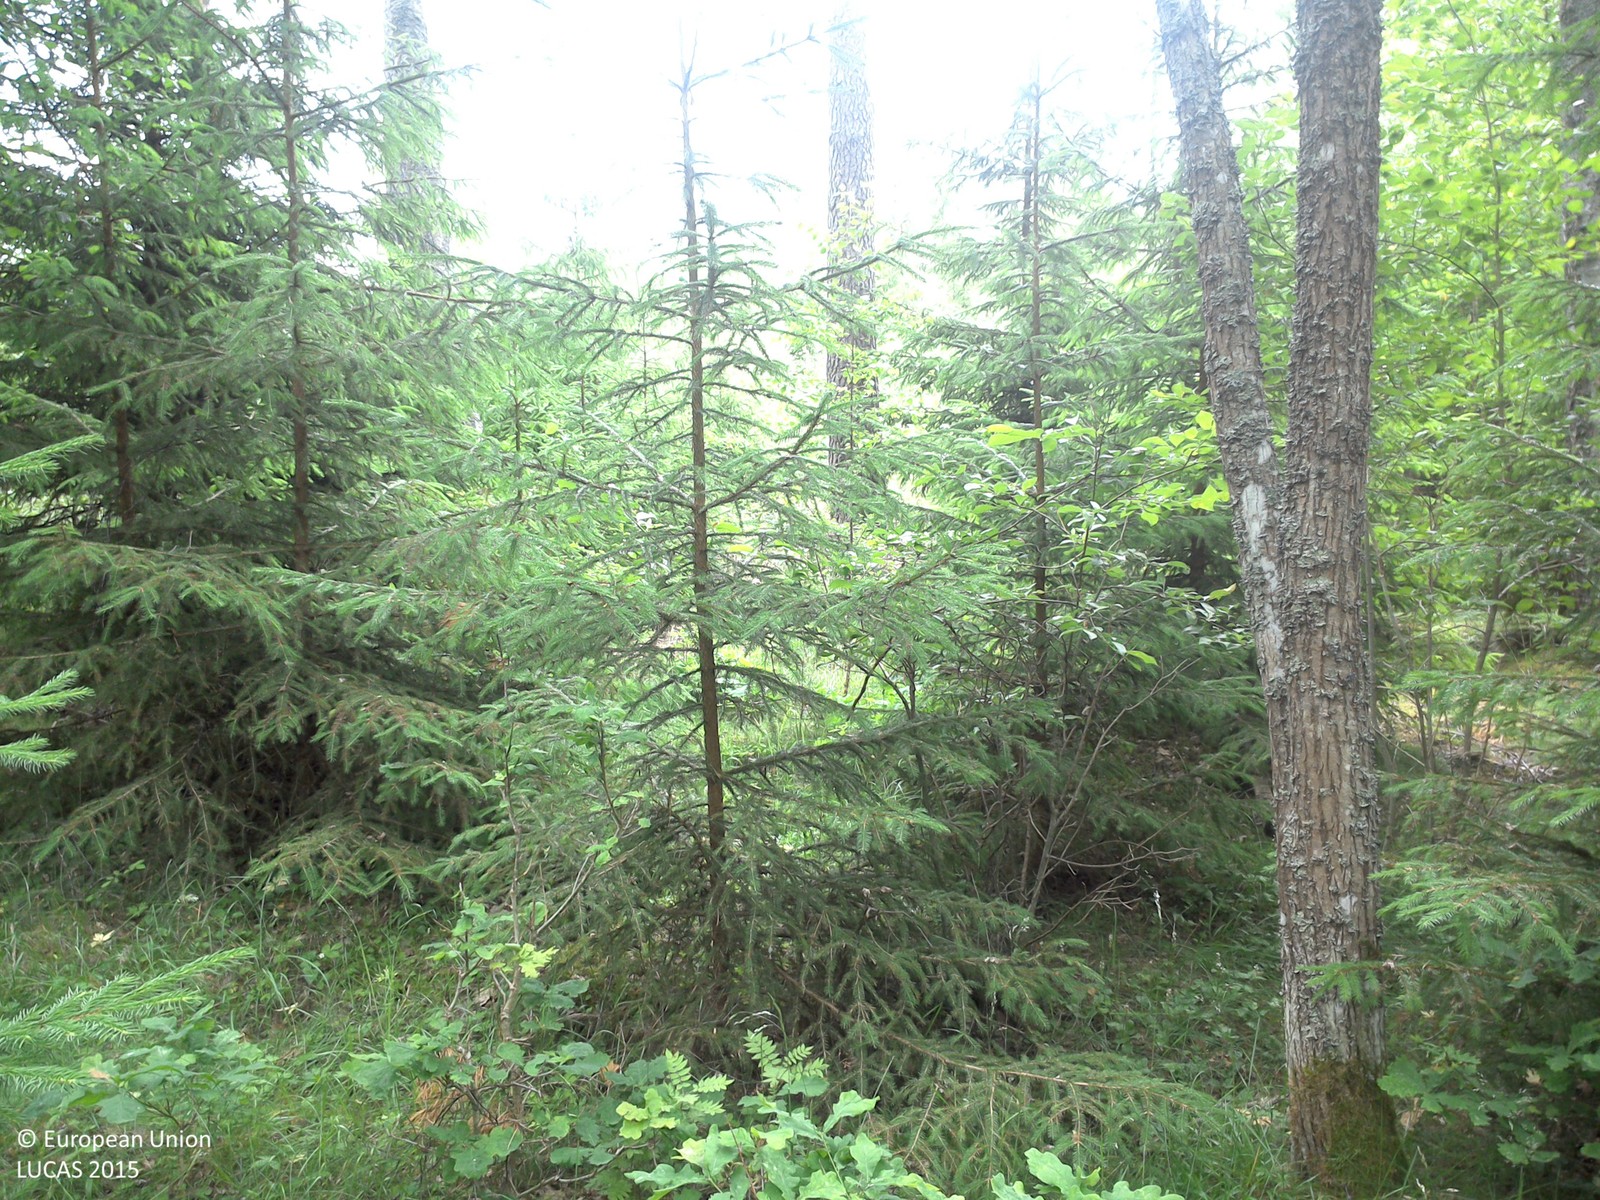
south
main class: Woodland
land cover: Pine dominated mixed woodland
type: boreal forest
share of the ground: 50 - 75 %
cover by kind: coniferous forest trees 55 %, herbaceous plants 25 %, broadleaved forest trees 20 %
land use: Forestry
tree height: > 5 m
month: June
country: SE
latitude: 58.4140
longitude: 15.4891
